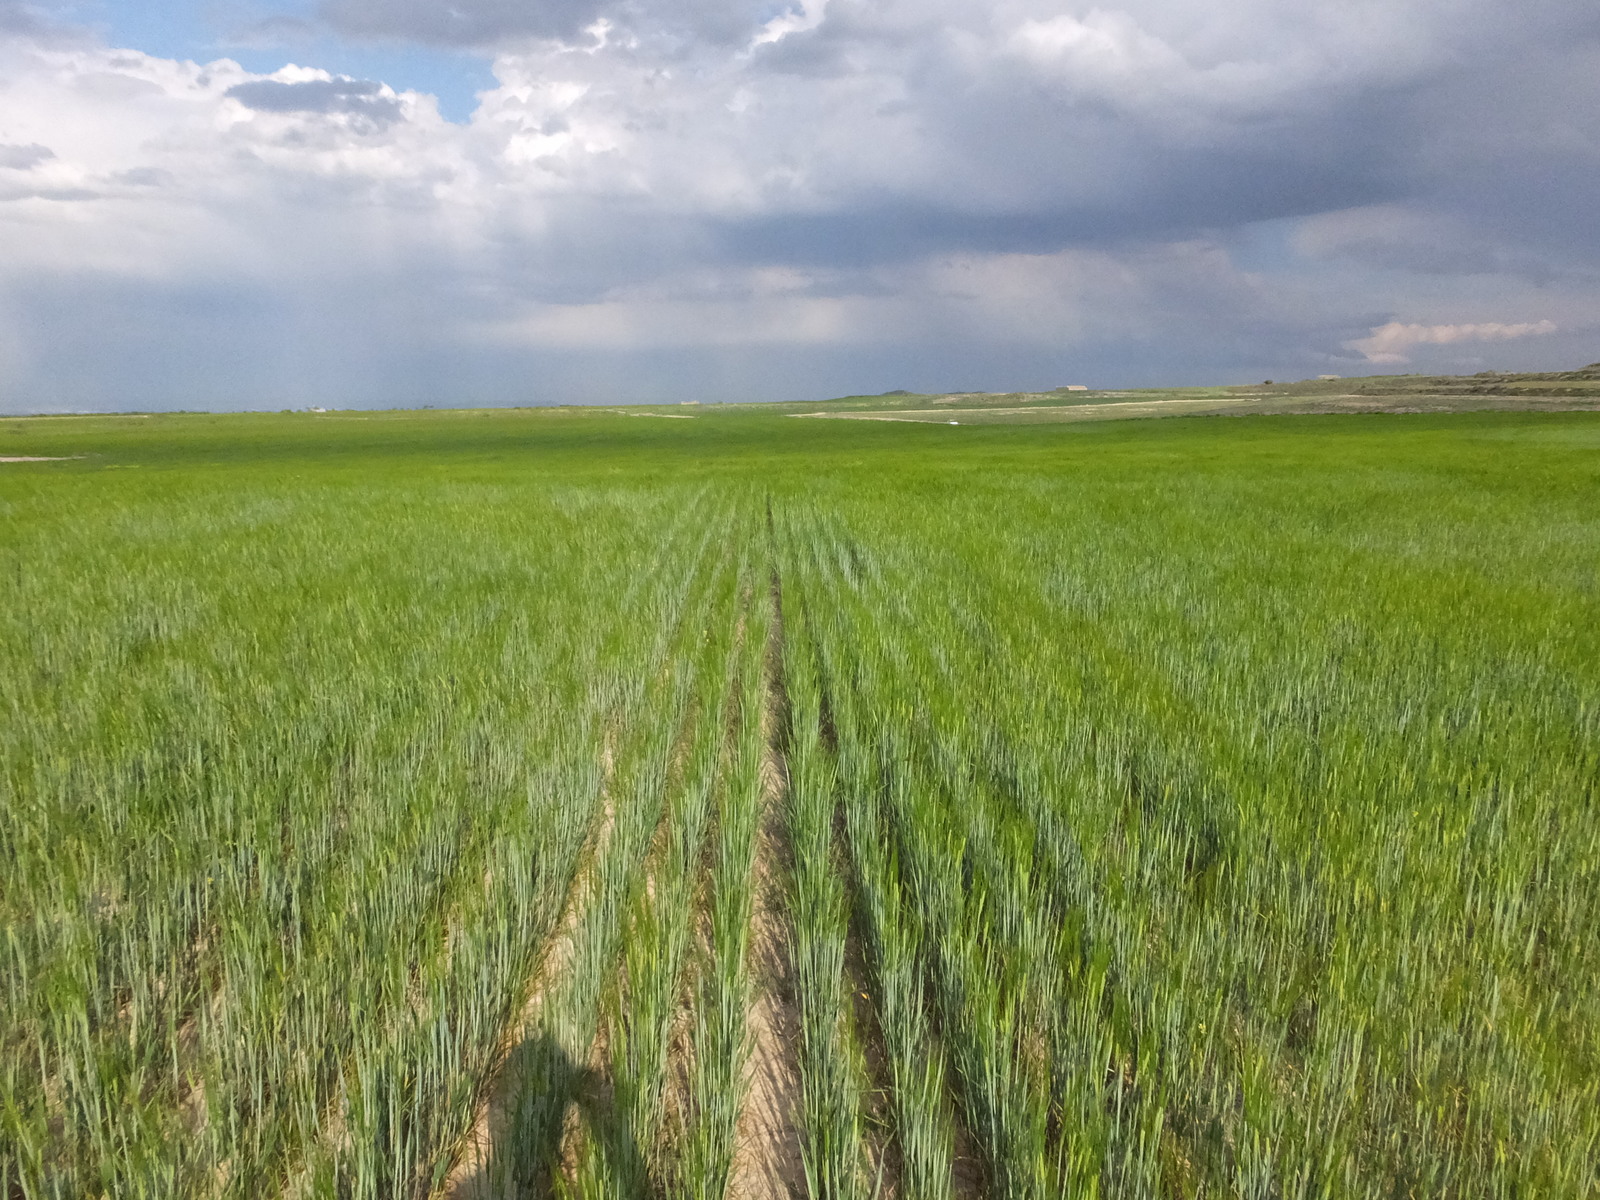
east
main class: Cropland
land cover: Barley
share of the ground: > 75 %
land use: Agriculture (excluding fallow land and kitchen gardens)
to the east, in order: Barley
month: April
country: ES
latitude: 41.7227
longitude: -0.3444
